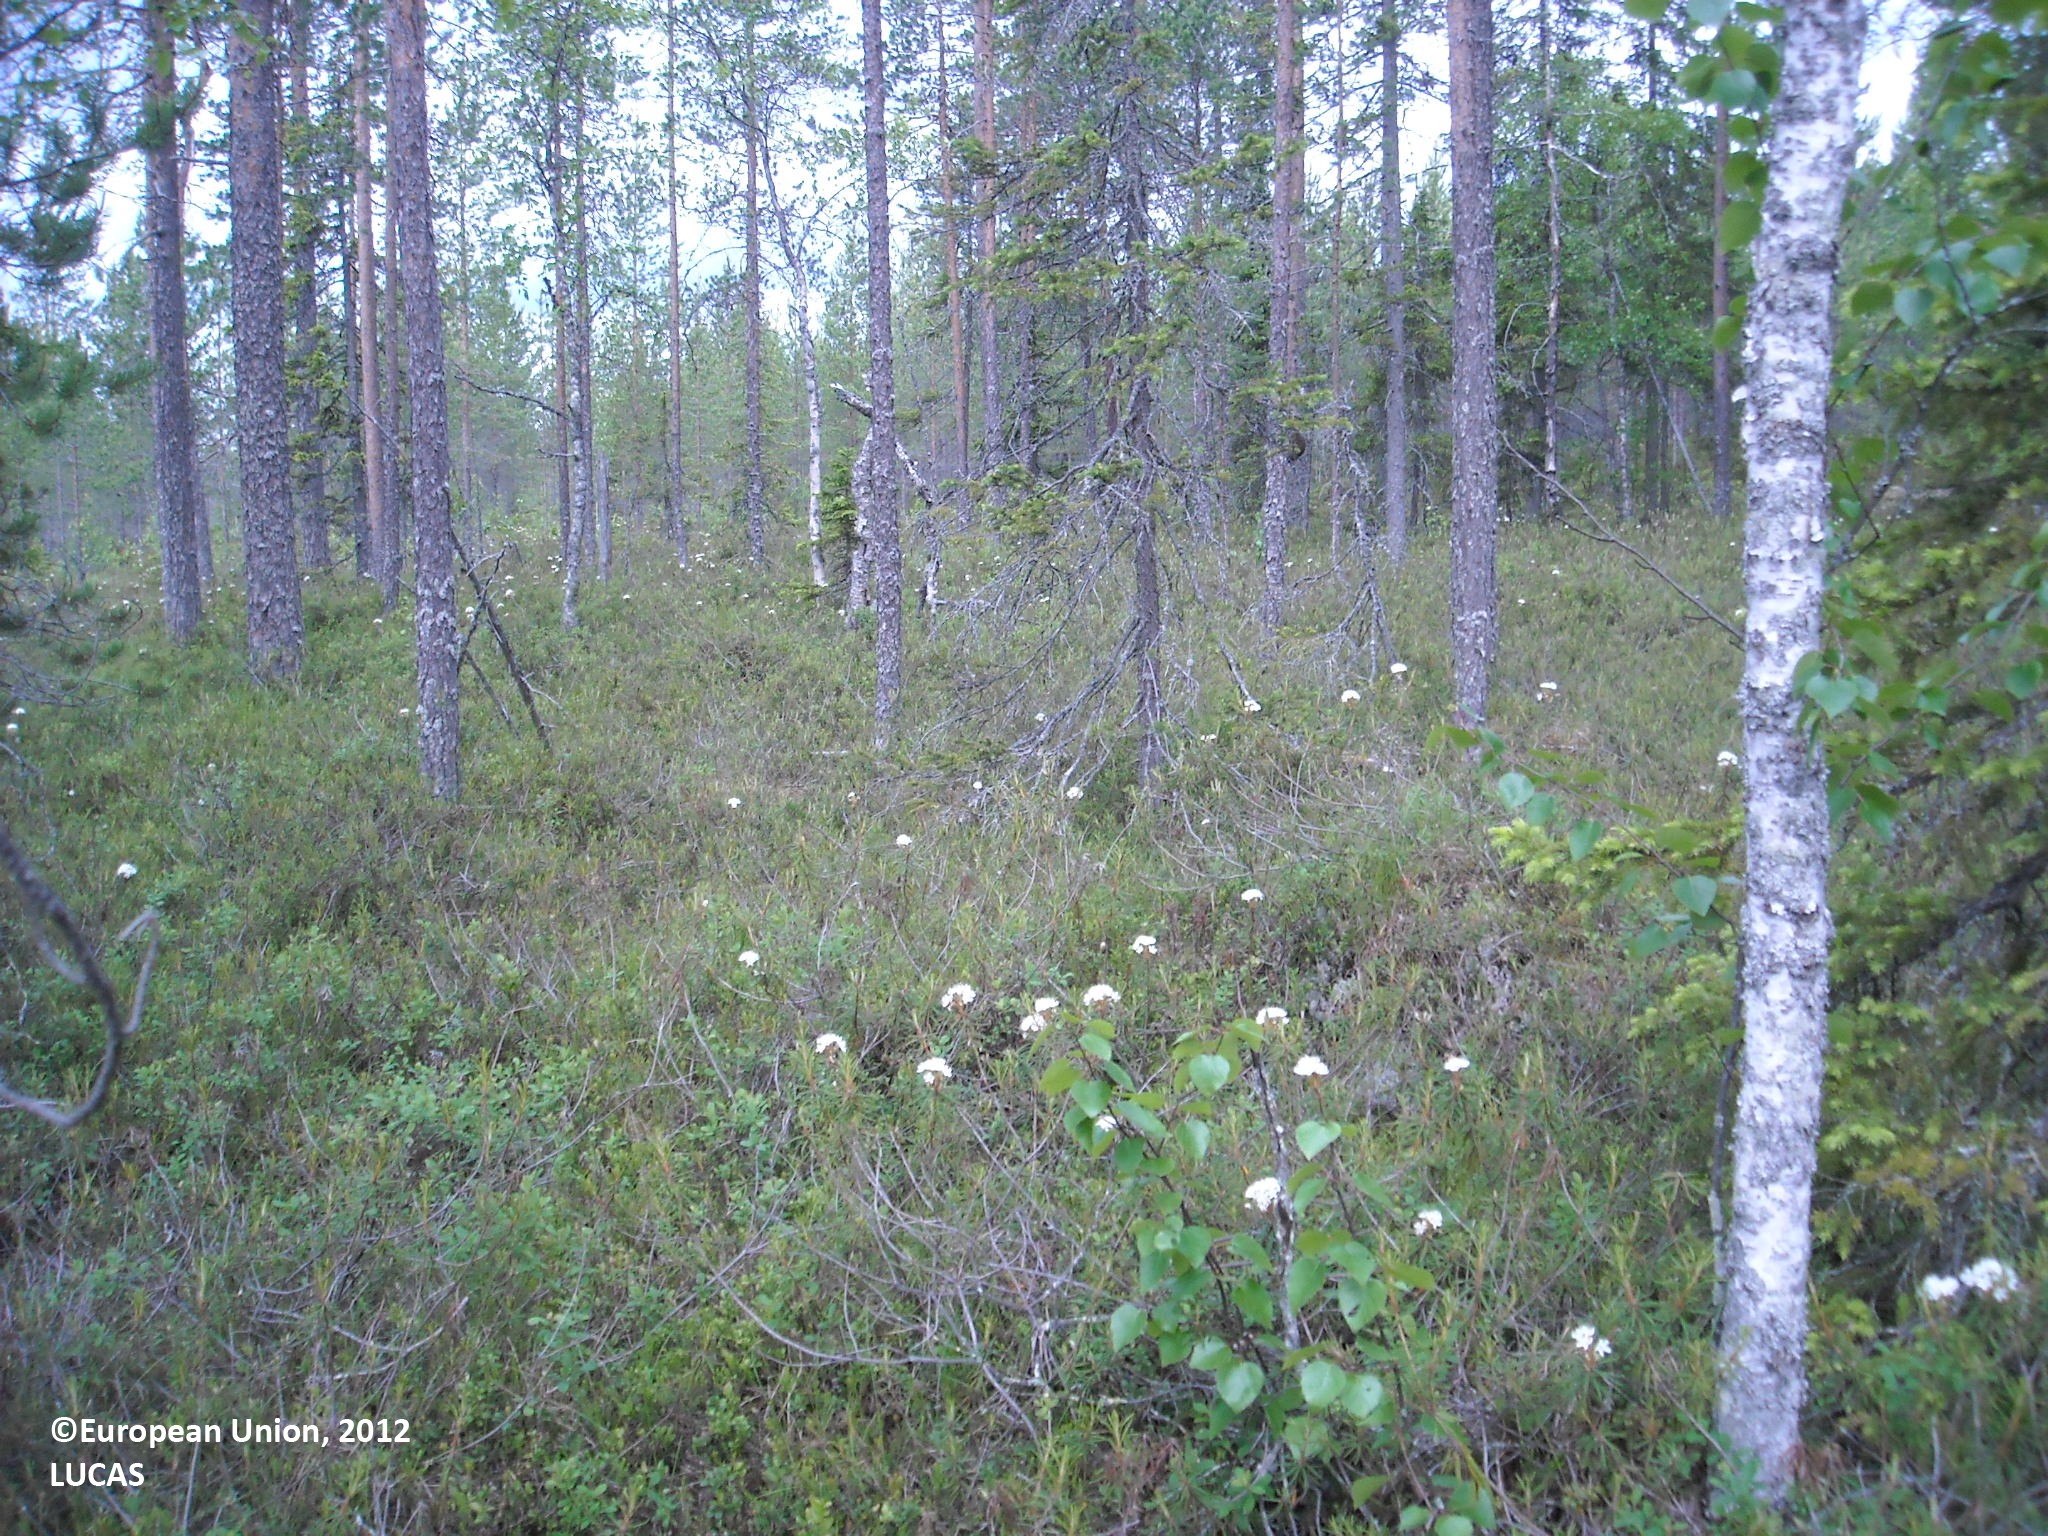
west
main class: Woodland
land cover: Pine dominated coniferous woodland
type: mire and swamp forests
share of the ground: > 75 %
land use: Forestry
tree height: > 5 m
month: June
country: FI
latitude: 64.8332
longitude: 27.7877
